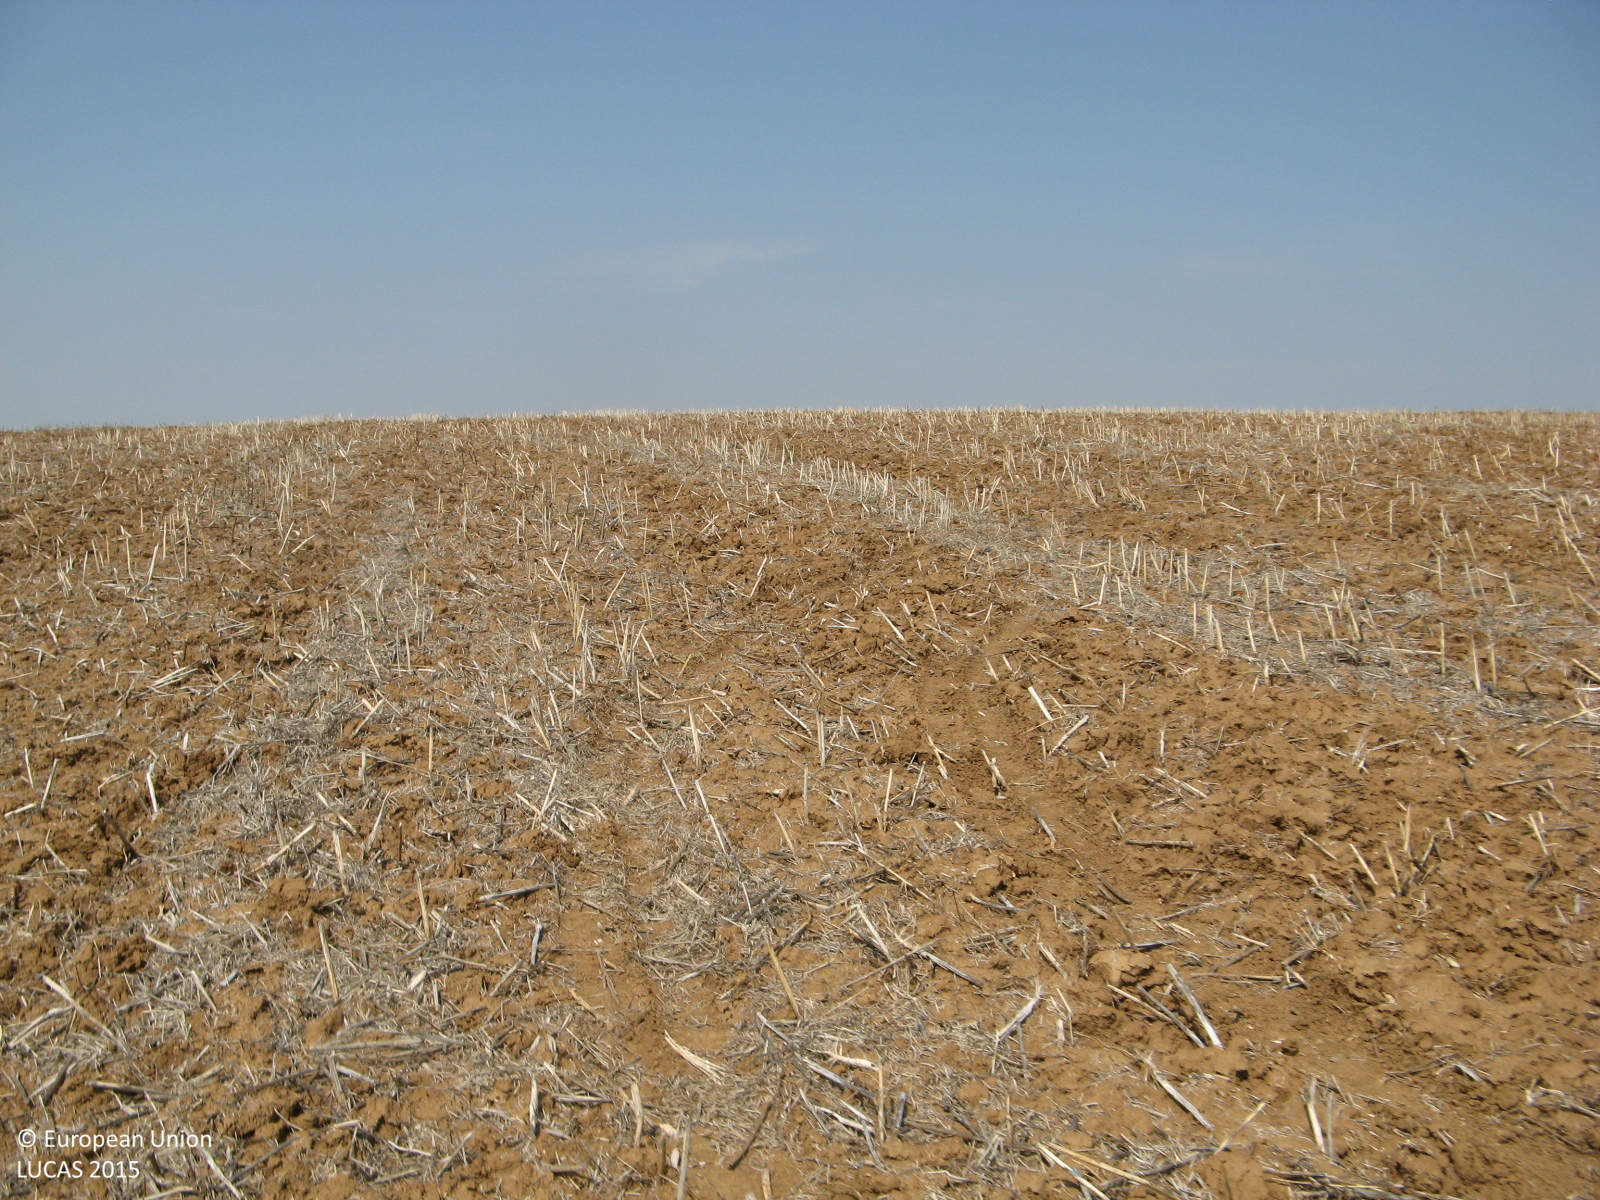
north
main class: Cropland
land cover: Rape and turnip rape
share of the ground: < 10 %
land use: Agriculture (excluding fallow land and kitchen gardens)
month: August
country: BG
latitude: 43.3976
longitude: 25.8549
